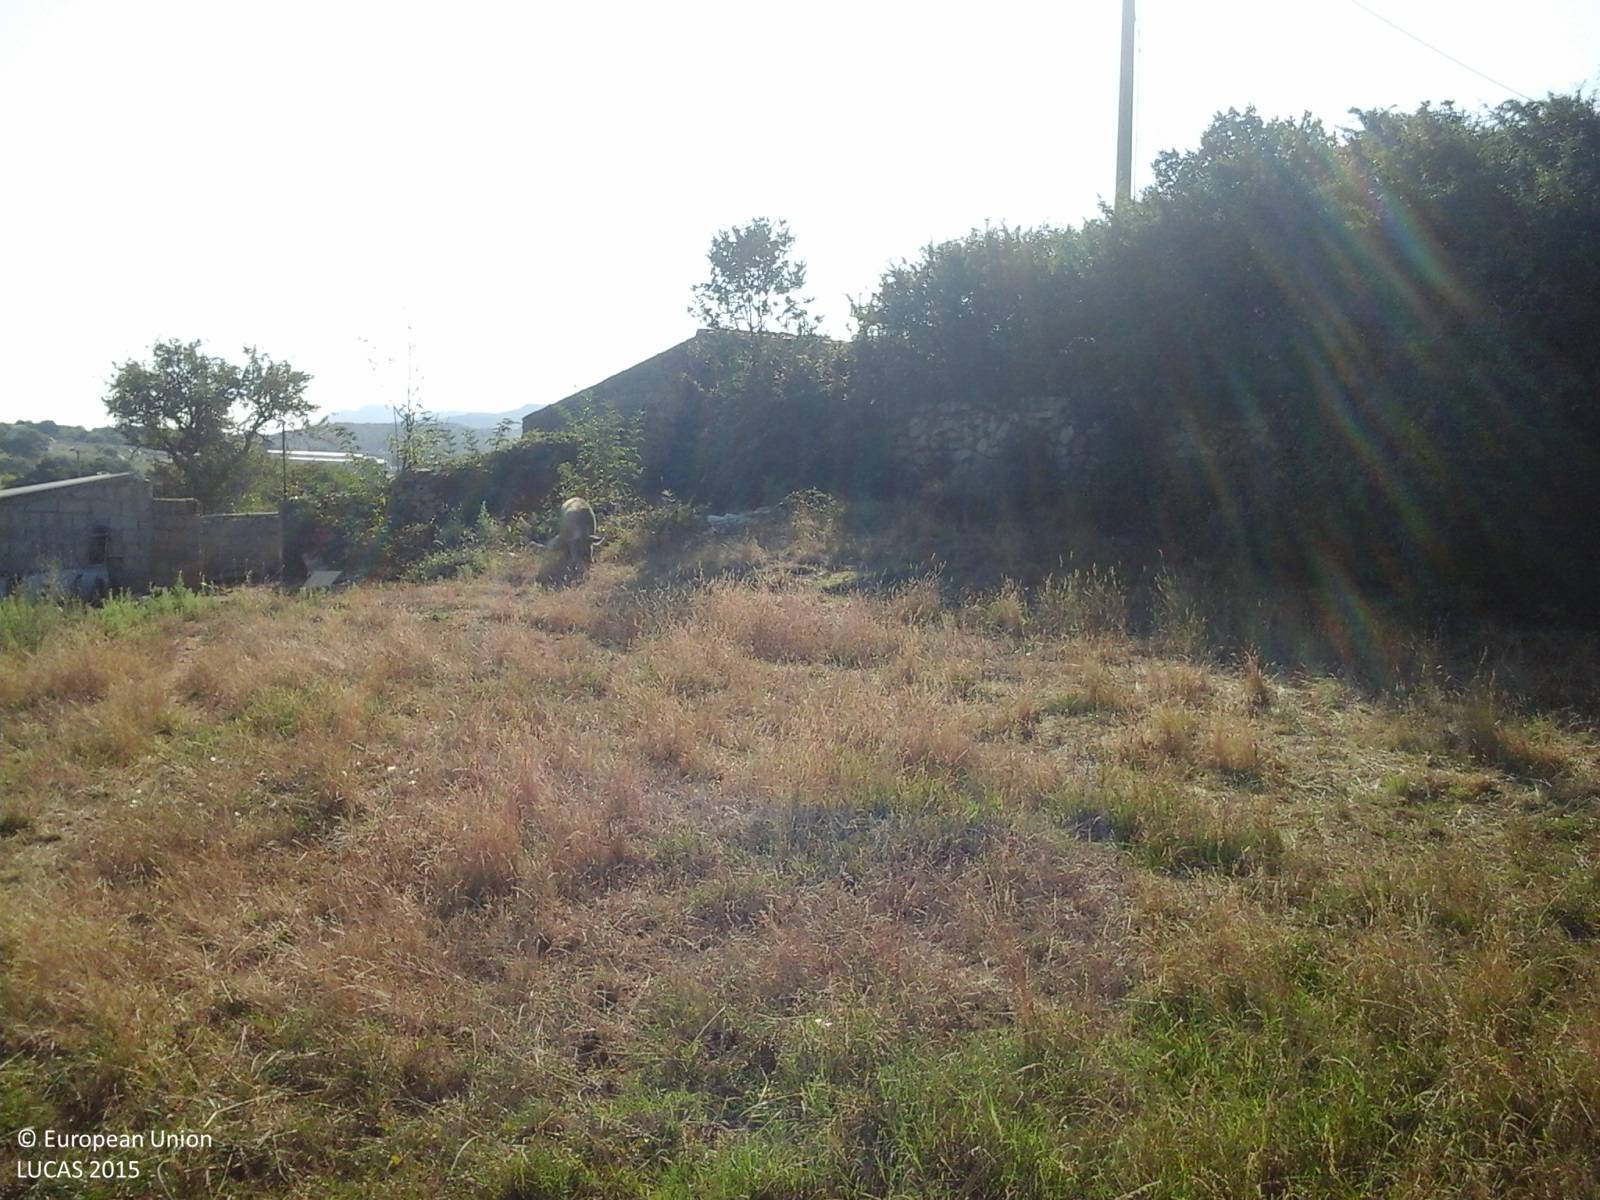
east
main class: Grassland
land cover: Grassland without tree/shrub cover
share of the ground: > 75 %
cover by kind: herbaceous plants 100 %
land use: Agriculture (excluding fallow land and kitchen gardens)
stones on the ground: < 10 %
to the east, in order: Grassland without tree/shrub cover; Artificial constructions in urban areas; Grassland without tree/shrub cover; Tracks; Oats; Electric lines; Oats; Abandoned hedges; Oats
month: August
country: IT
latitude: 40.9152
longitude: 9.1609
